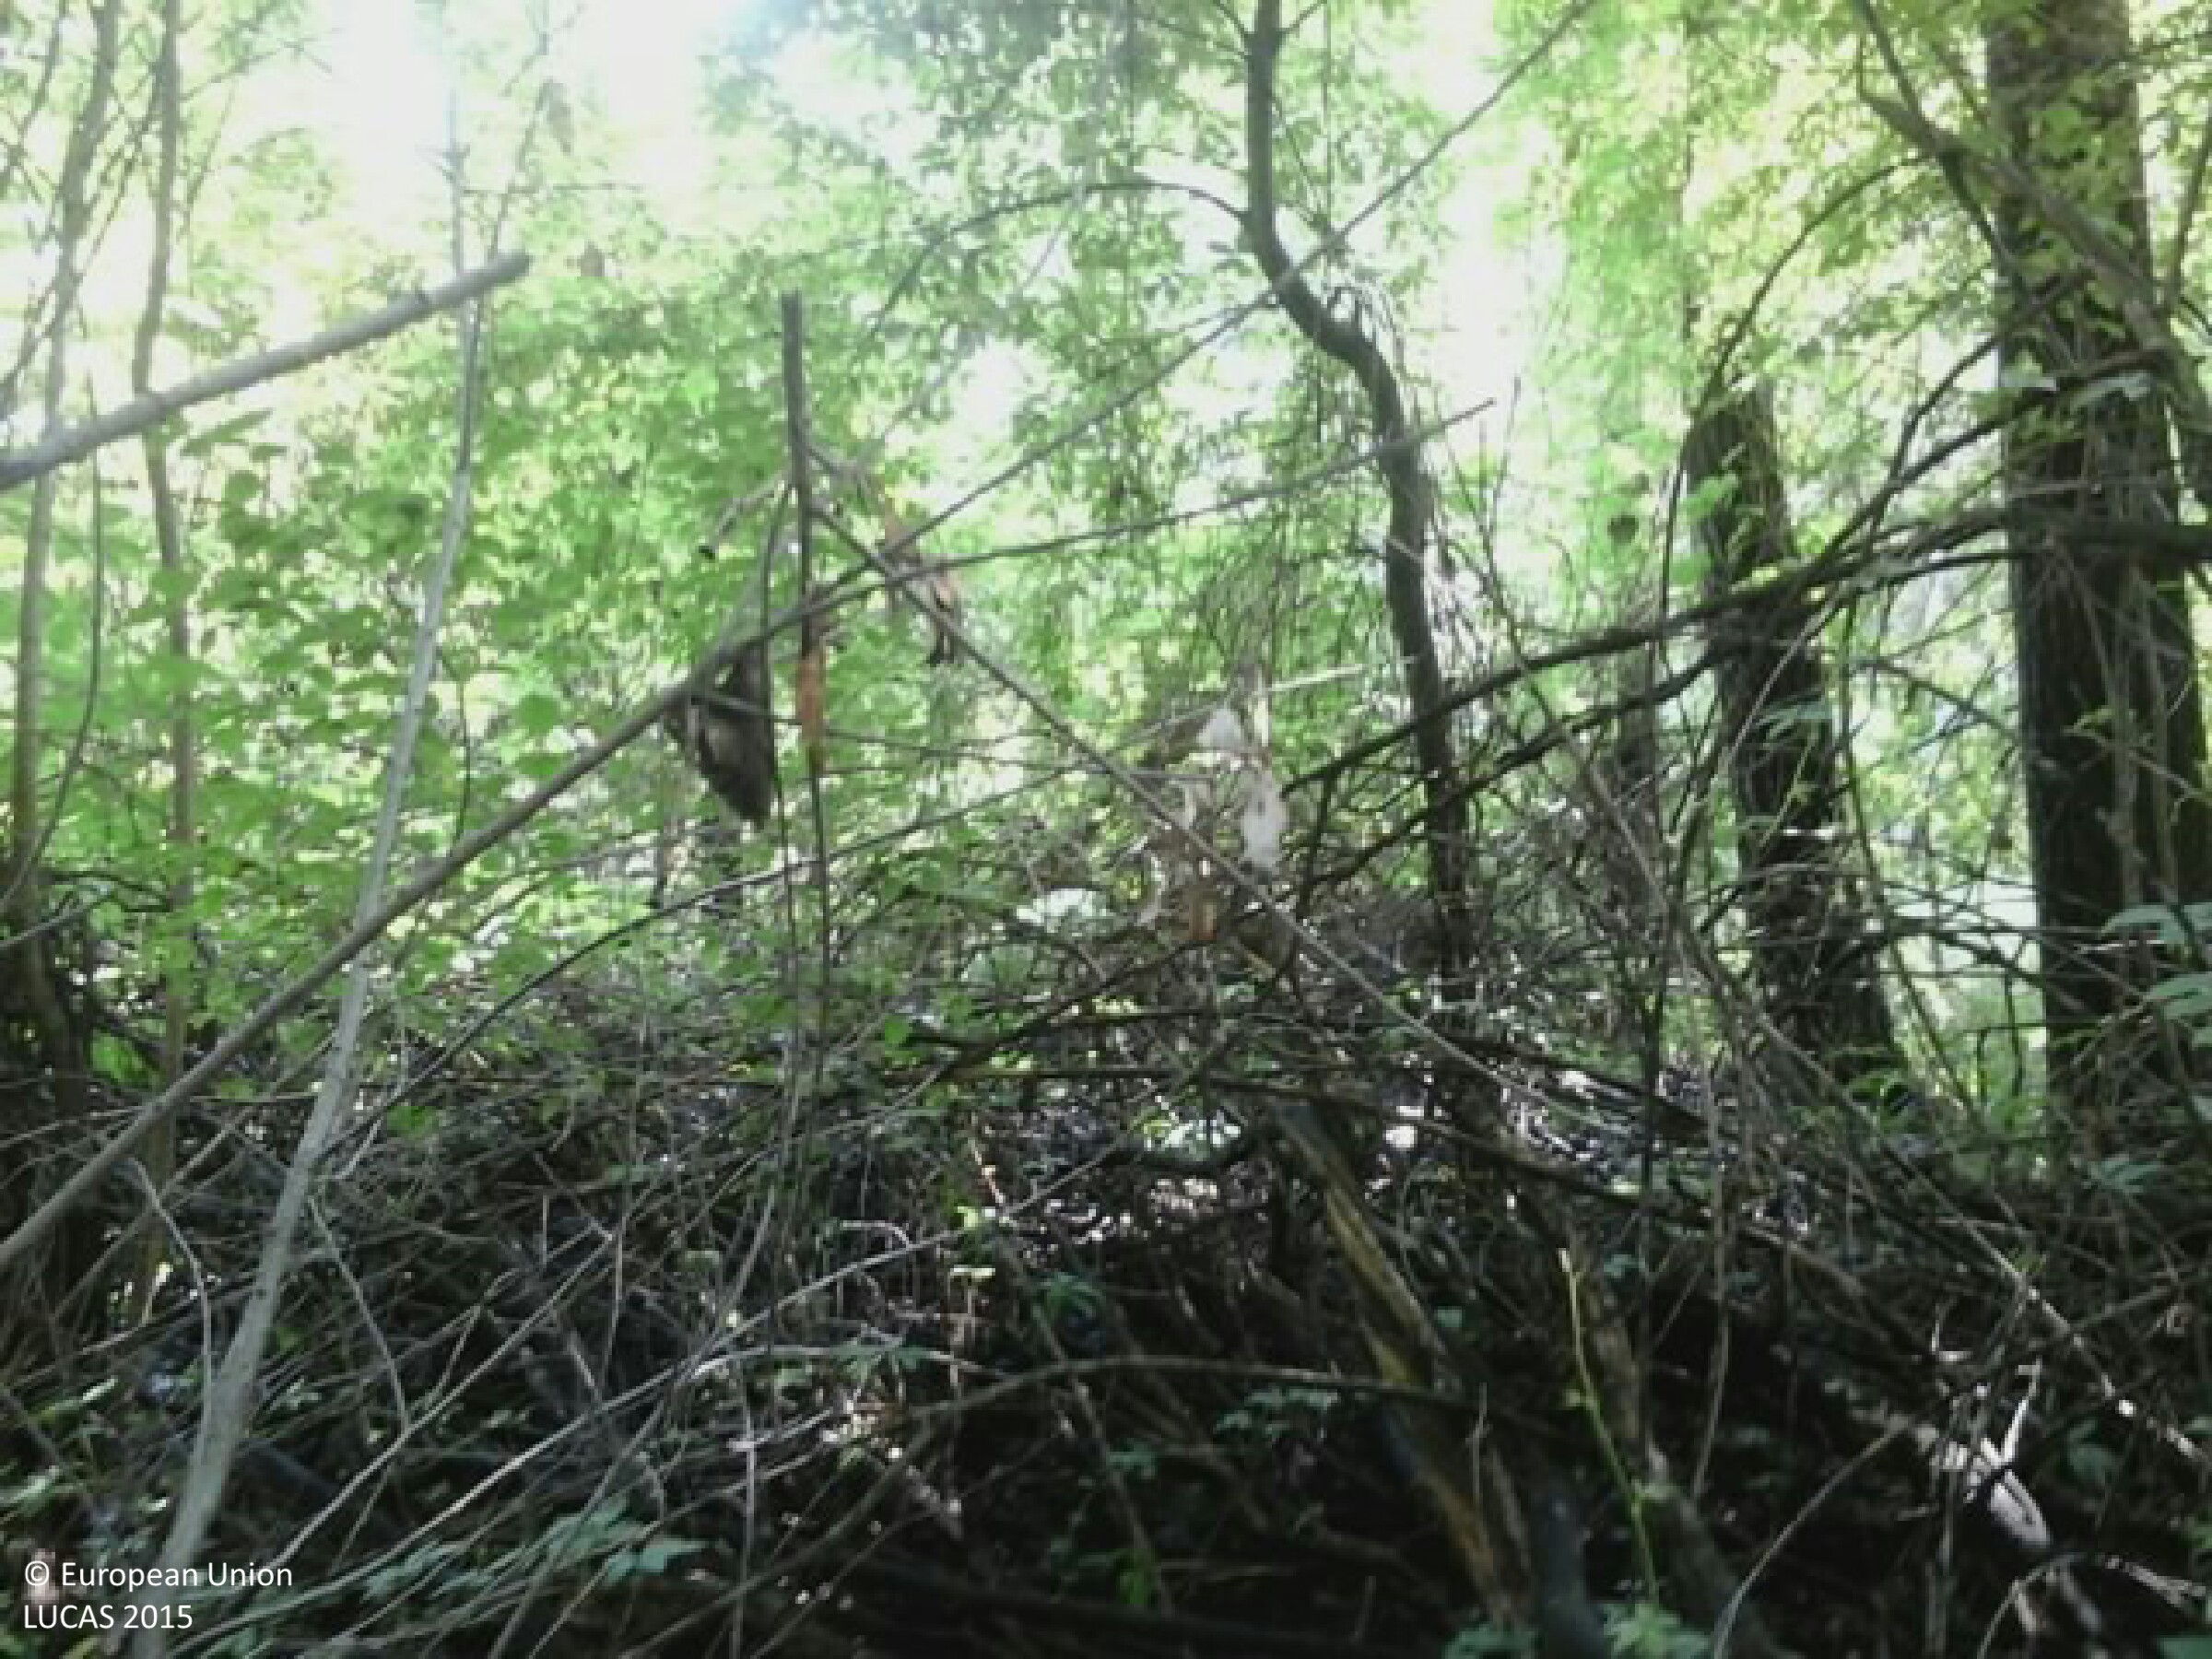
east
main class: Woodland
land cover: Broadleaved woodland
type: mesophytic deciduous forest
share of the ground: > 75 %
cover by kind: broadleaved forest trees 85 %, shrubs 10 %, herbaceous plants 5 %
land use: Forestry
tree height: > 5 m
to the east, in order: Broadleaved woodland; Tracks; Grass margins; Broadleaved woodland; Grassland without tree/shrub cover; Tracks; Grassland without tree/shrub cover; Grassland with sparse tree/shrub cover; Broadleaved woodland
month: August
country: HU
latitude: 47.1613
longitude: 19.6906
